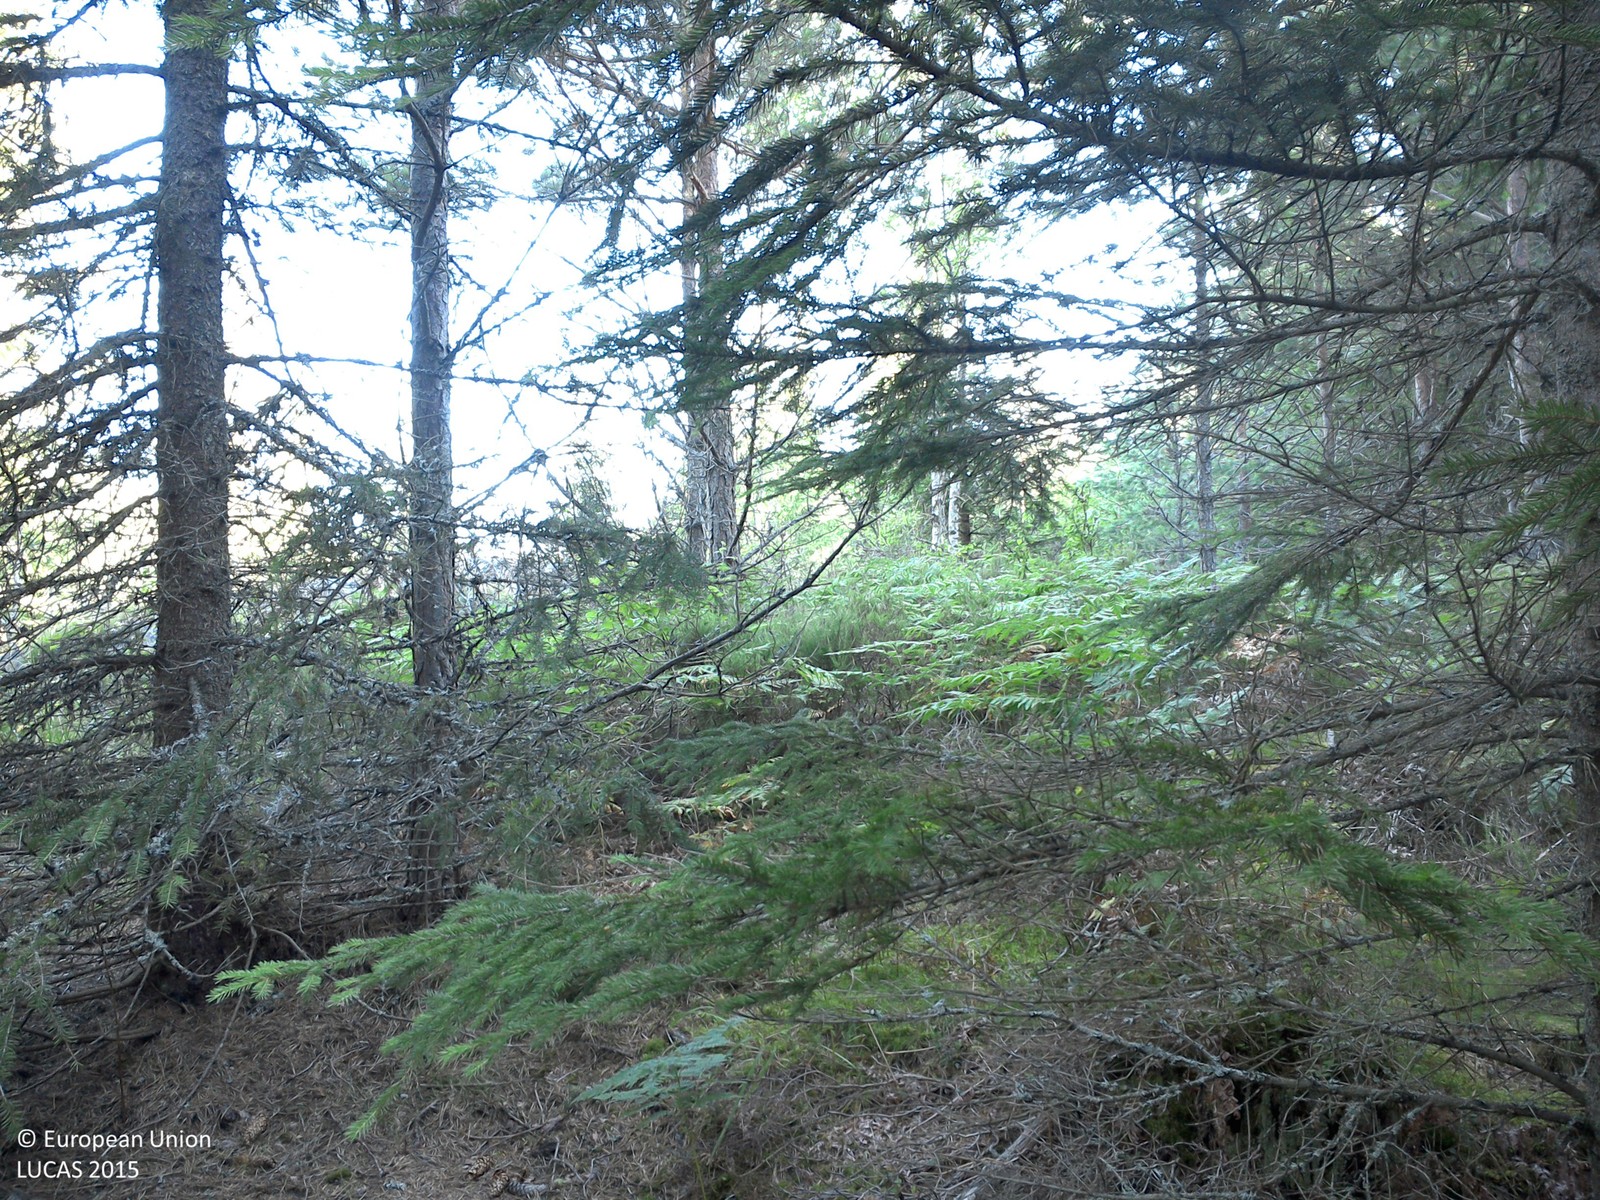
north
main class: Woodland
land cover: Spruce dominated coniferous woodland
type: boreal forest
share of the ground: 50 - 75 %
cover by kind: coniferous forest trees 60 %, herbaceous plants 30 %, lichens and mosses 10 %
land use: Forestry
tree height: > 5 m
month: August
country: SE
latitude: 57.8893
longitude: 15.9508
